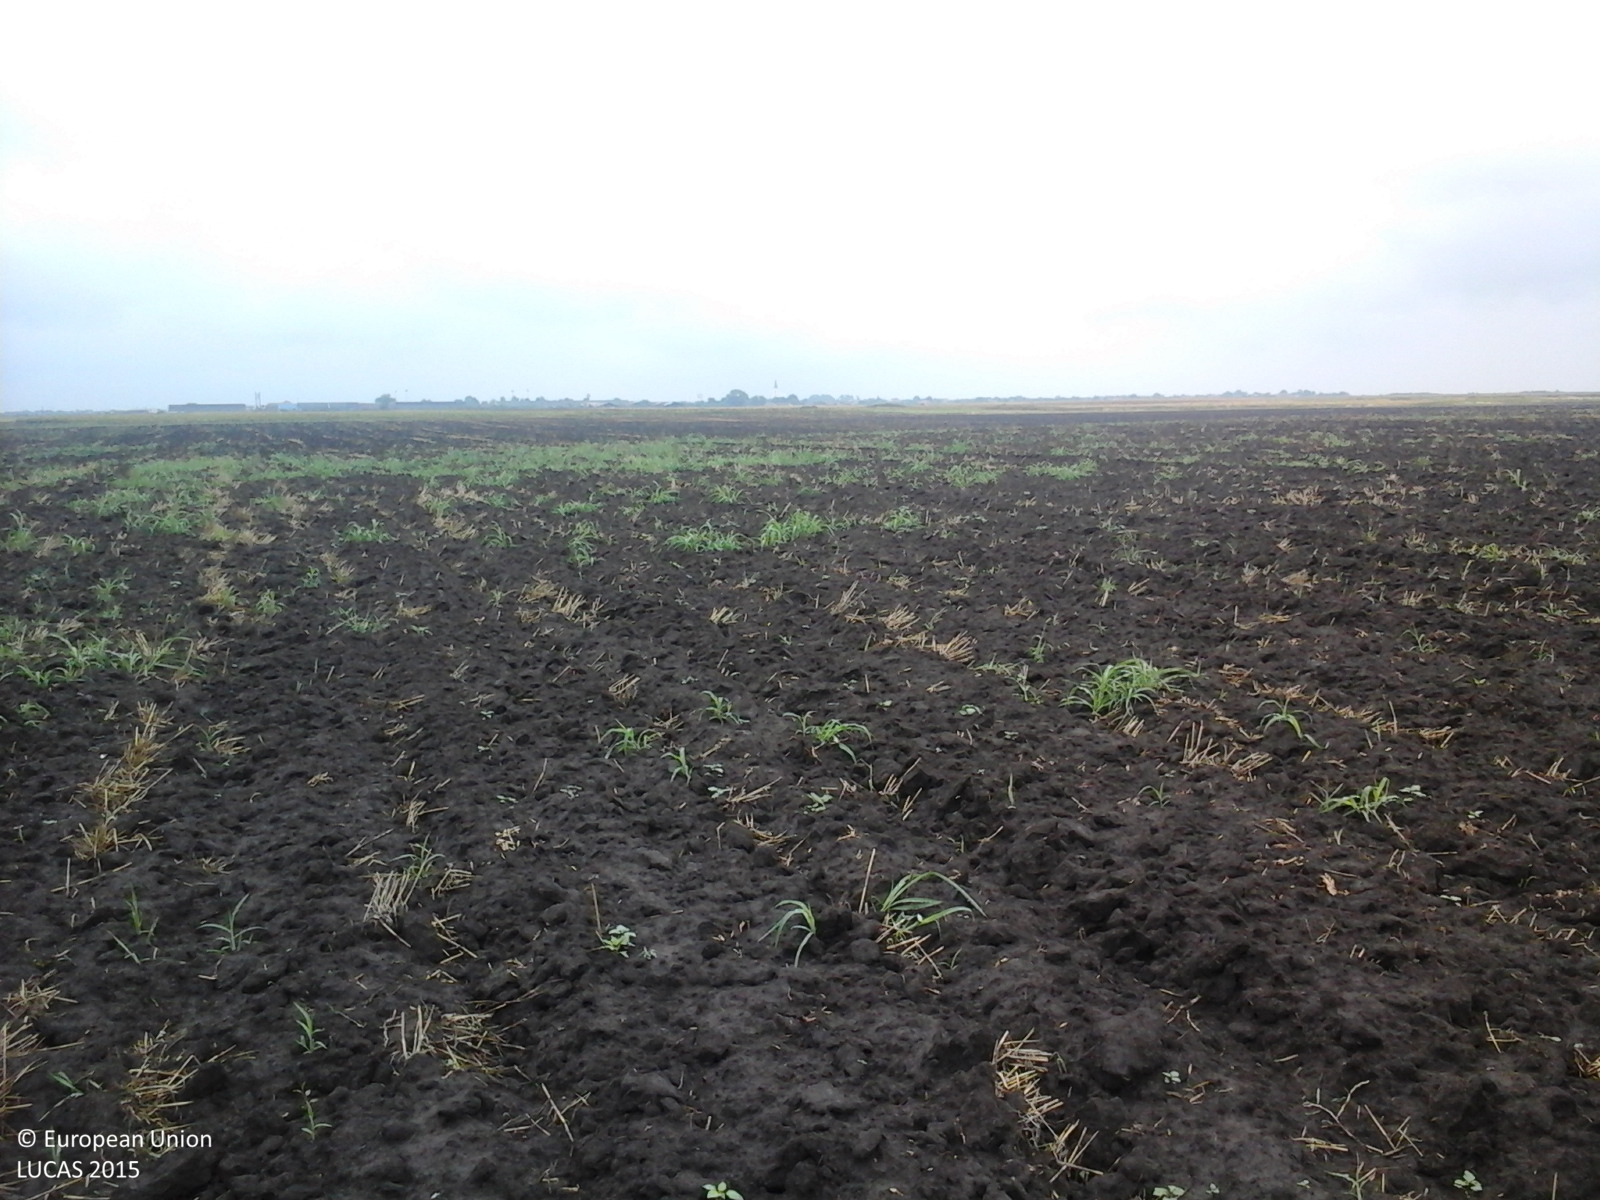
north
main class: Cropland
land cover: Common wheat
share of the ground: < 10 %
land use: Agriculture (excluding fallow land and kitchen gardens)
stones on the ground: < 10 %
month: August
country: RO
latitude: 46.0172
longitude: 20.4733
